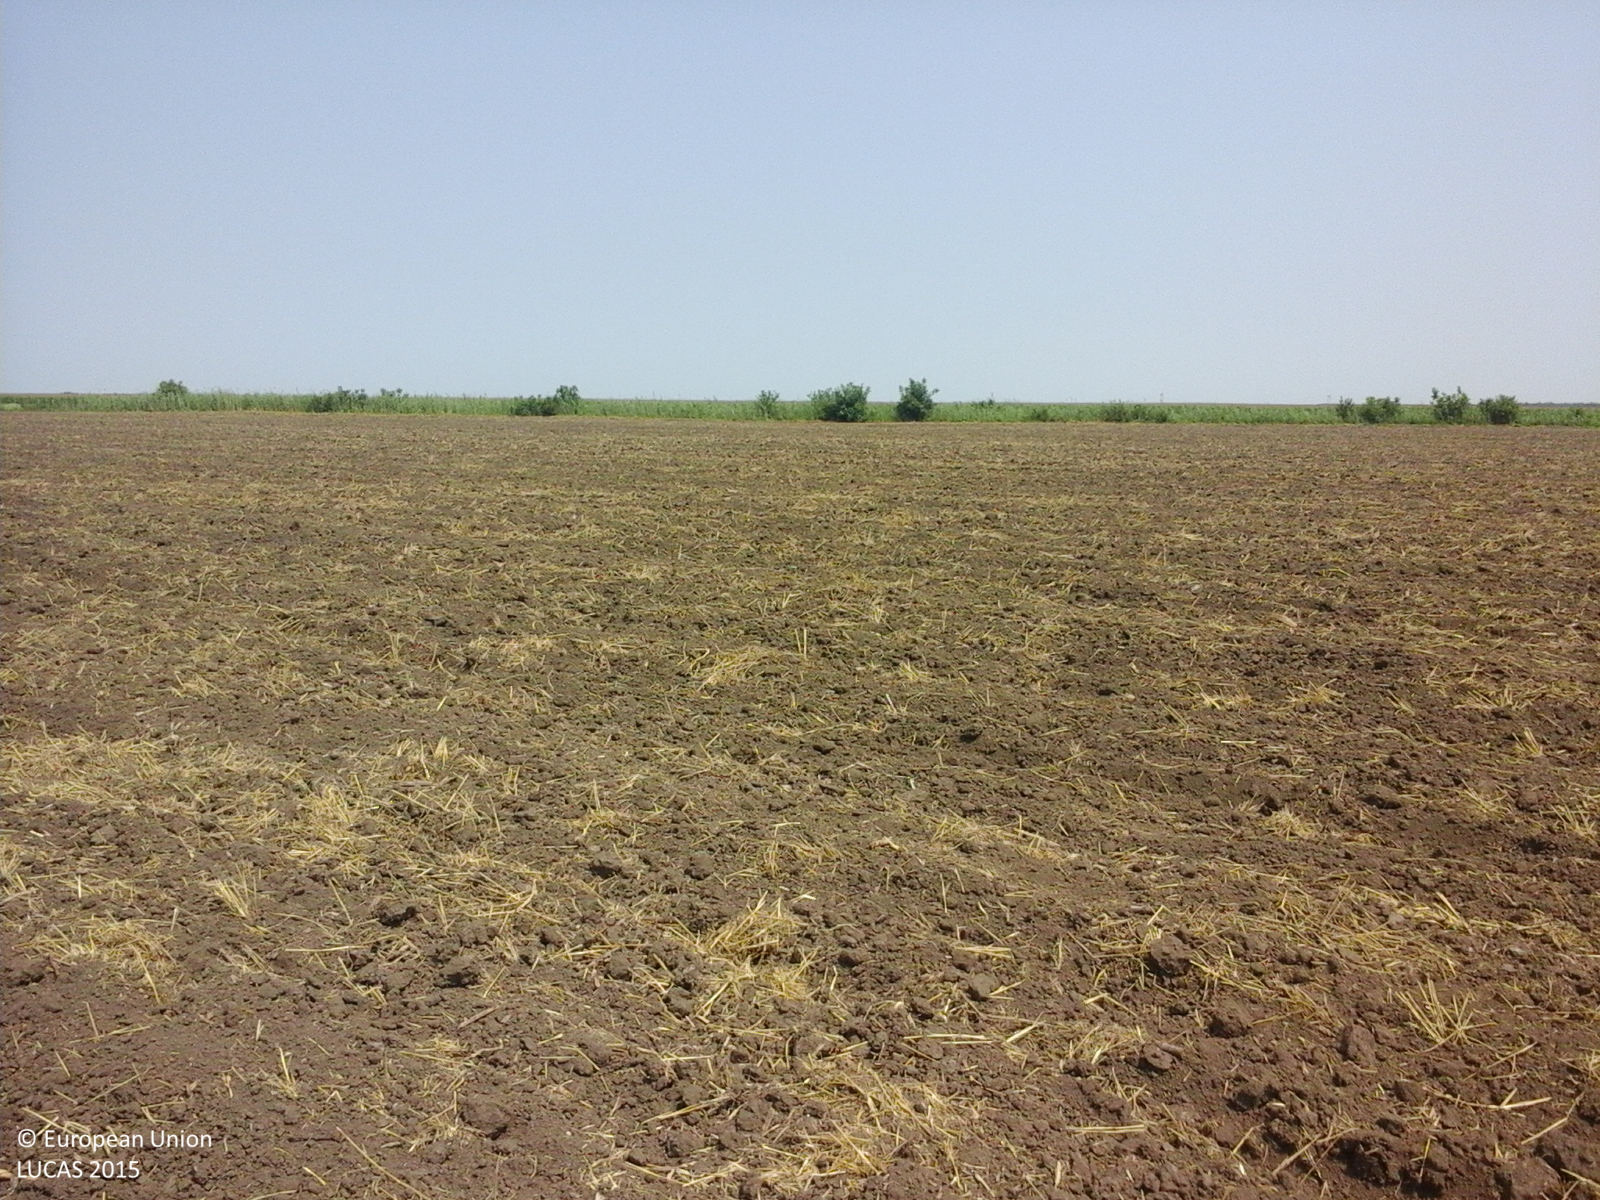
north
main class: Cropland
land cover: Common wheat
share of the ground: < 10 %
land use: Agriculture (excluding fallow land and kitchen gardens)
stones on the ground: < 10 %
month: July
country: RO
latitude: 44.5271
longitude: 26.7183
